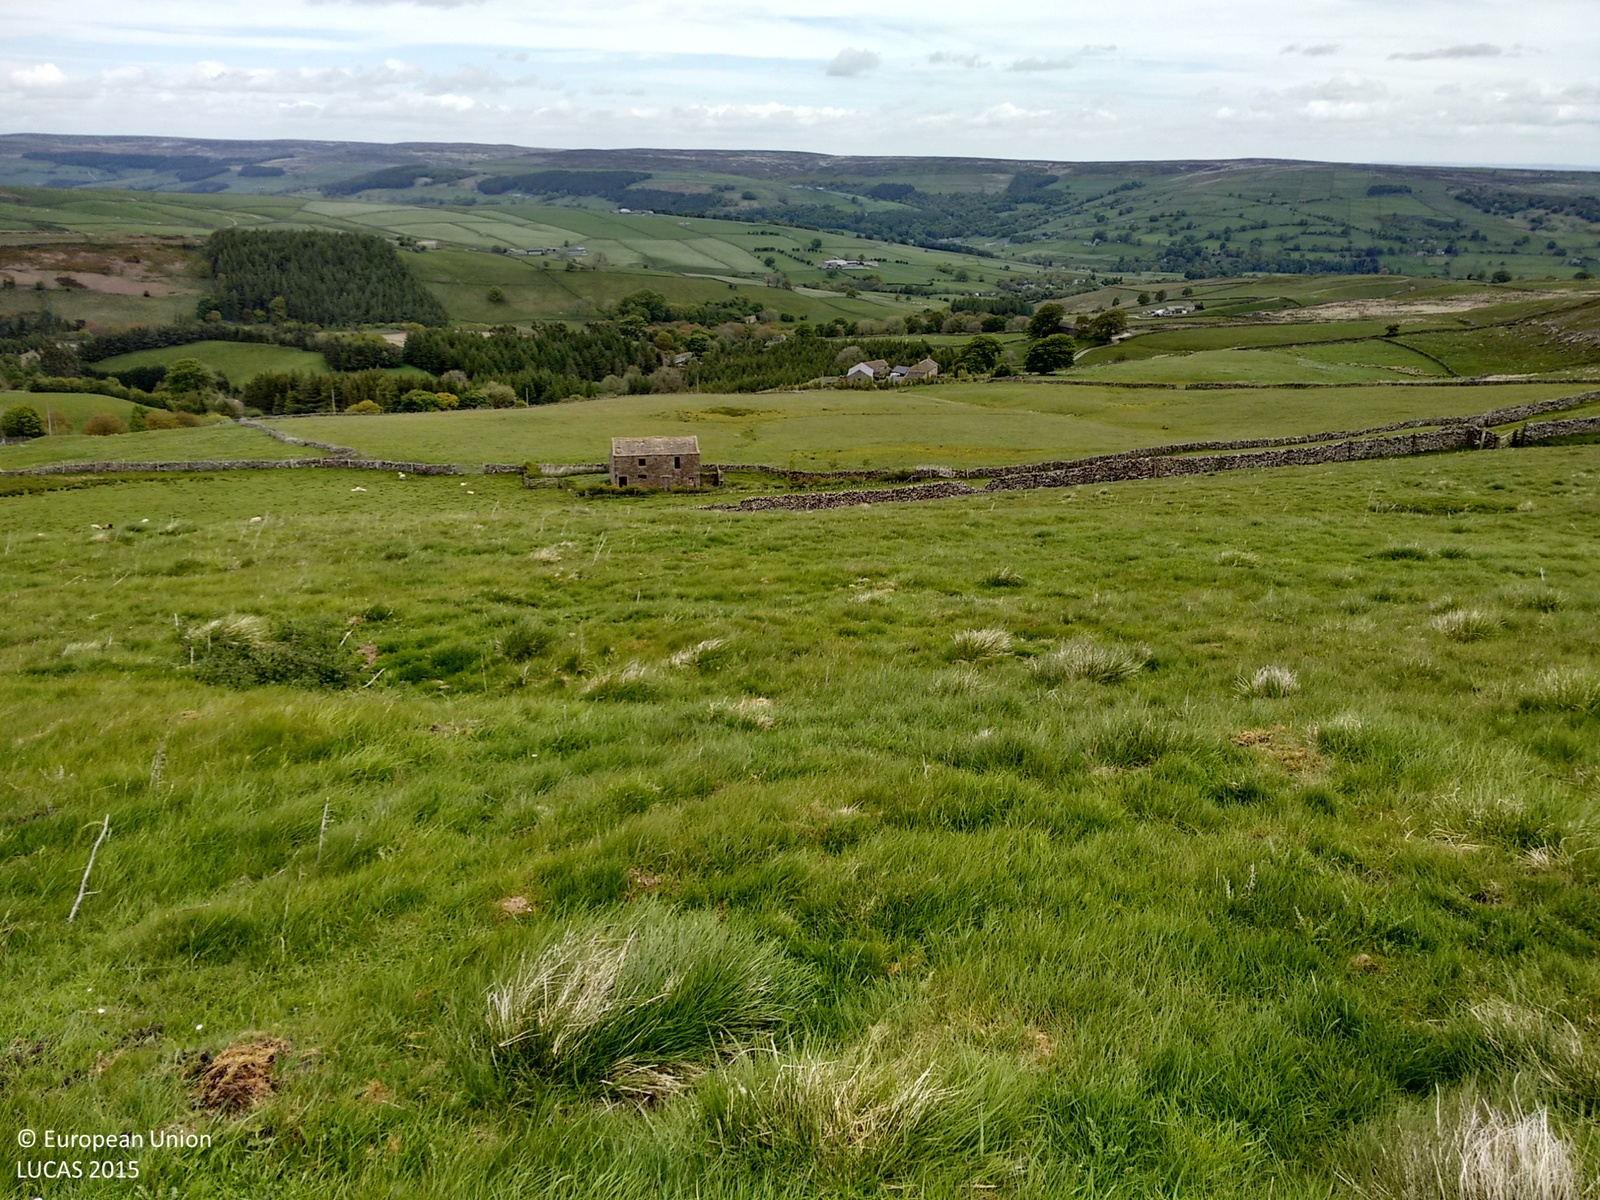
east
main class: Grassland
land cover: Grassland without tree/shrub cover
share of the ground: > 75 %
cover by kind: herbaceous plants 100 %
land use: Agriculture (excluding fallow land and kitchen gardens)
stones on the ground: < 10 %
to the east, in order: Grassland without tree/shrub cover; Dry stone walls; Fences; Grassland without tree/shrub cover; Dry stone walls; Fences; Grassland without tree/shrub cover
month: June
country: GB
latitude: 54.0764
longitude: -1.8068
